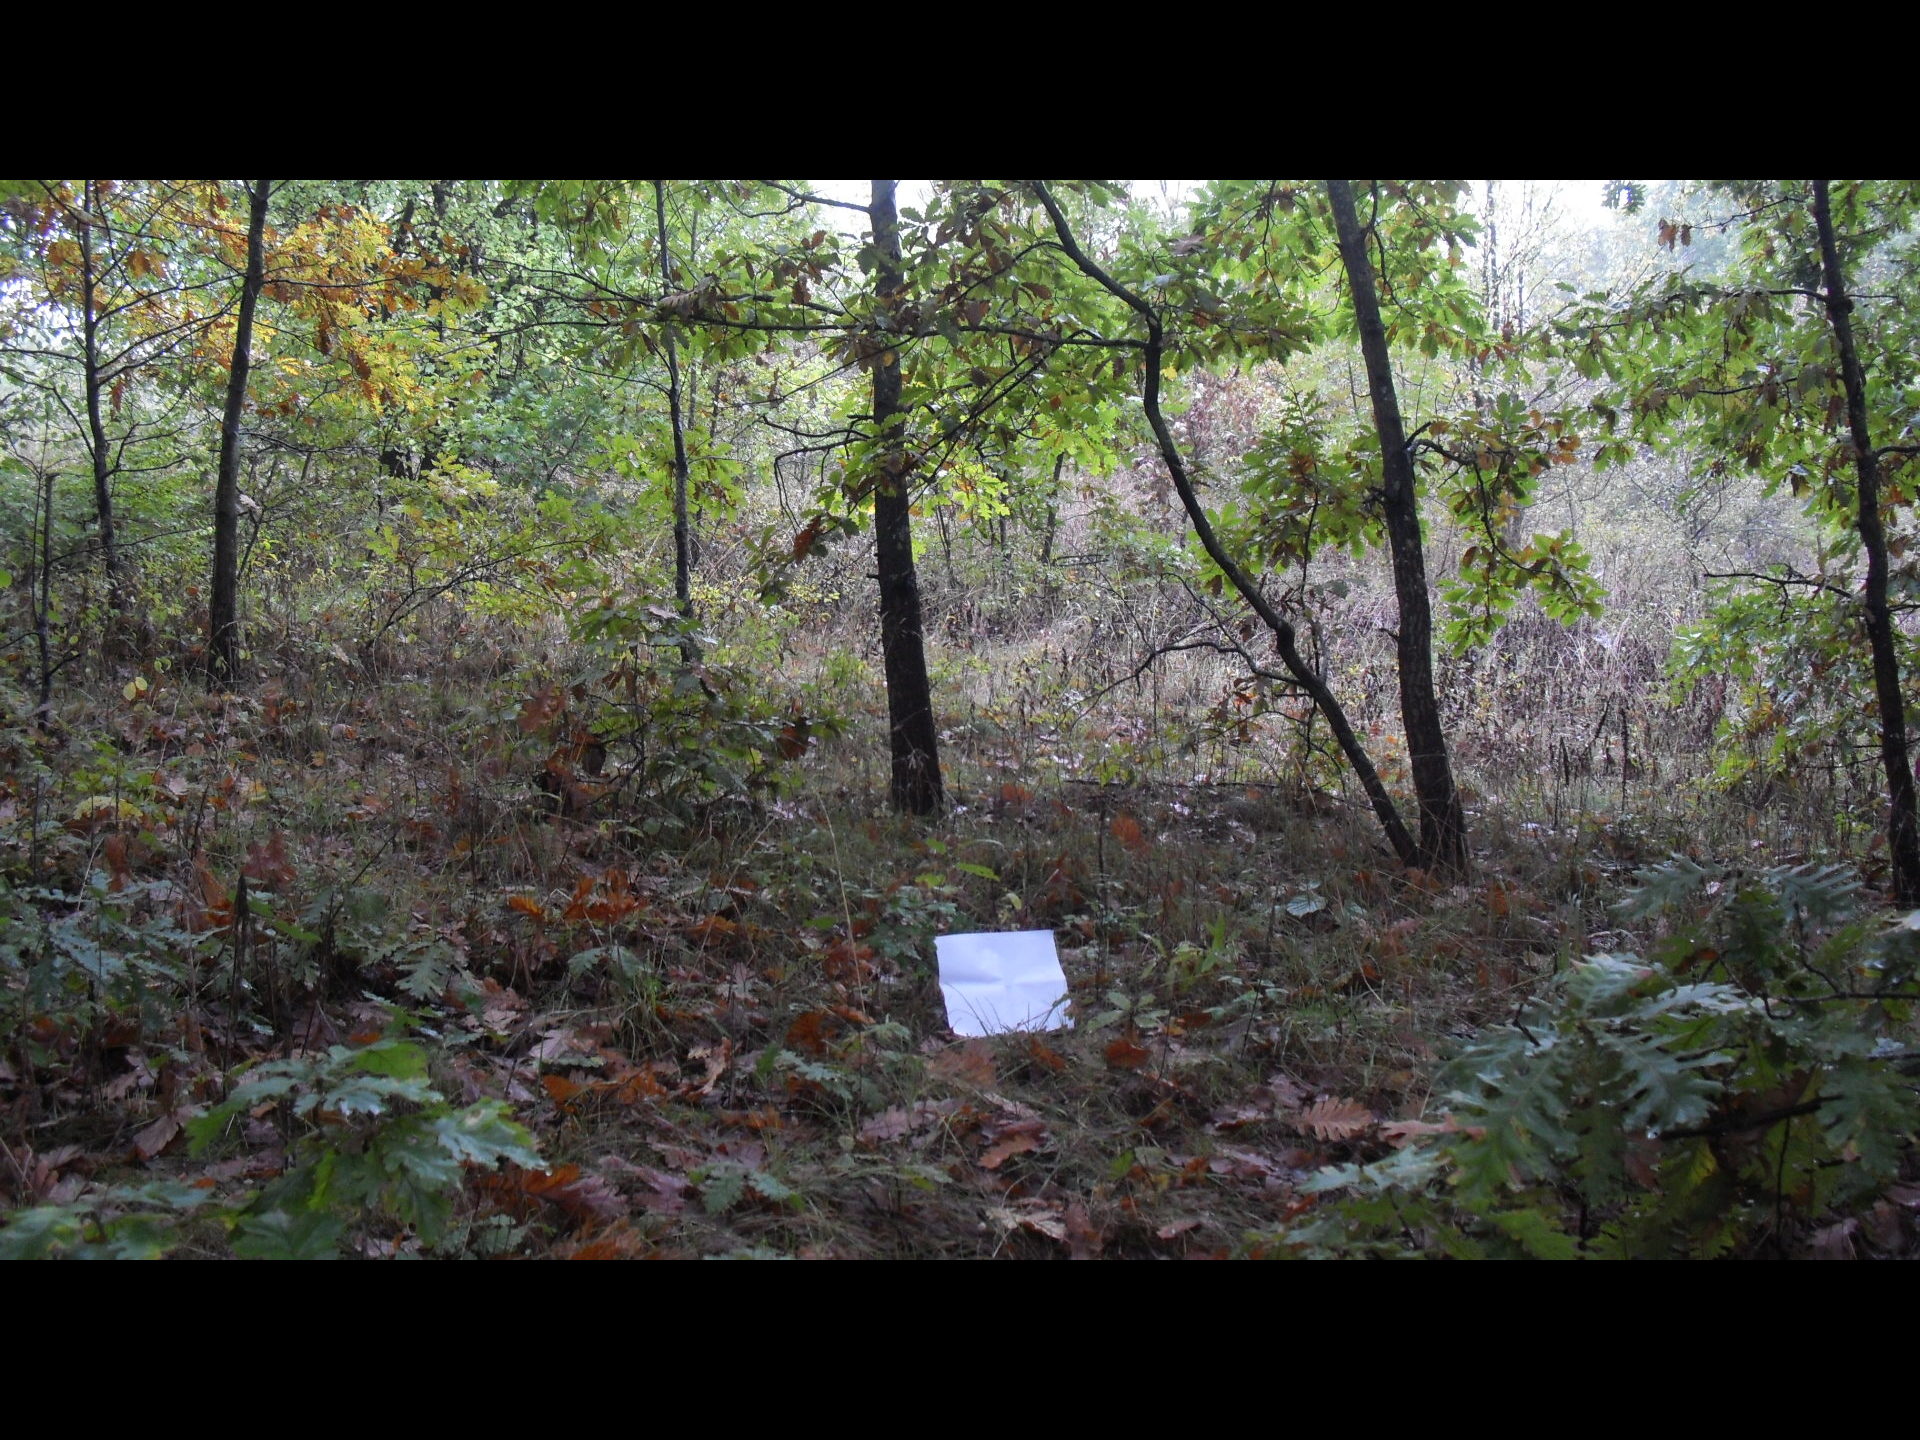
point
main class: Woodland
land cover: Broadleaved woodland
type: mesophytic deciduous forest
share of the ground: > 75 %
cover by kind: broadleaved forest trees 80 %, herbaceous plants 15 %, shrubs 5 %
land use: Forestry
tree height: > 5 m
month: October
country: BG
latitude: 43.6114
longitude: 22.6340
